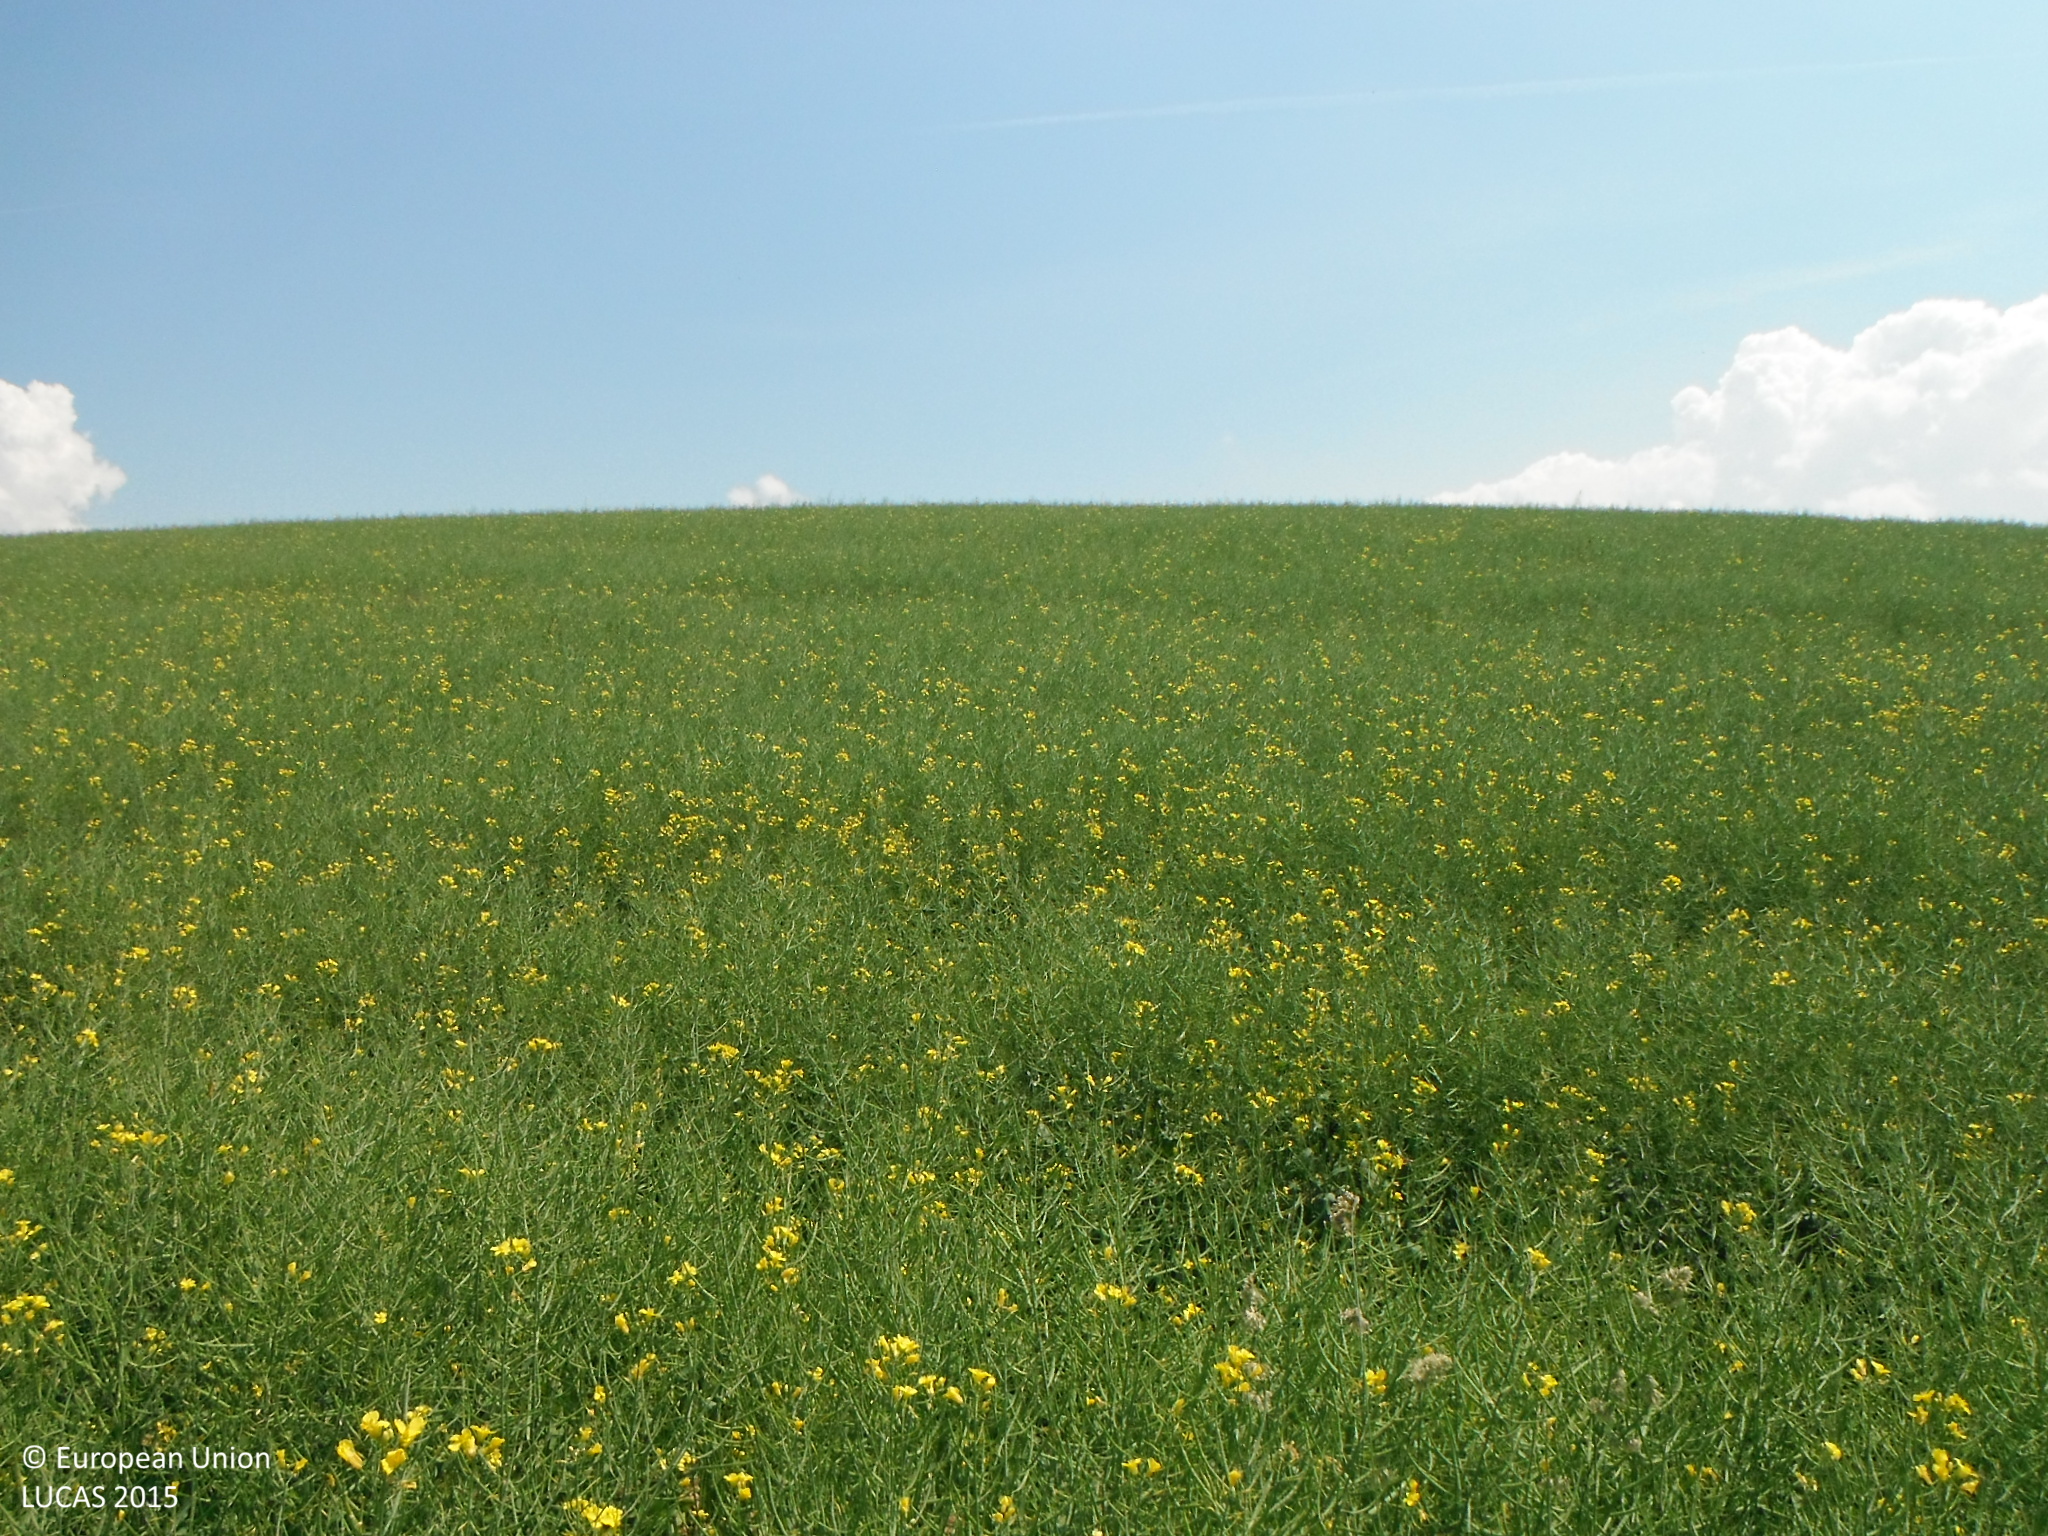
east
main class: Cropland
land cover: Rape and turnip rape
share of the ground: > 75 %
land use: Agriculture (excluding fallow land and kitchen gardens)
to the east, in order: Rape and turnip rape
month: June
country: SK
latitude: 49.0707
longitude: 19.4016
